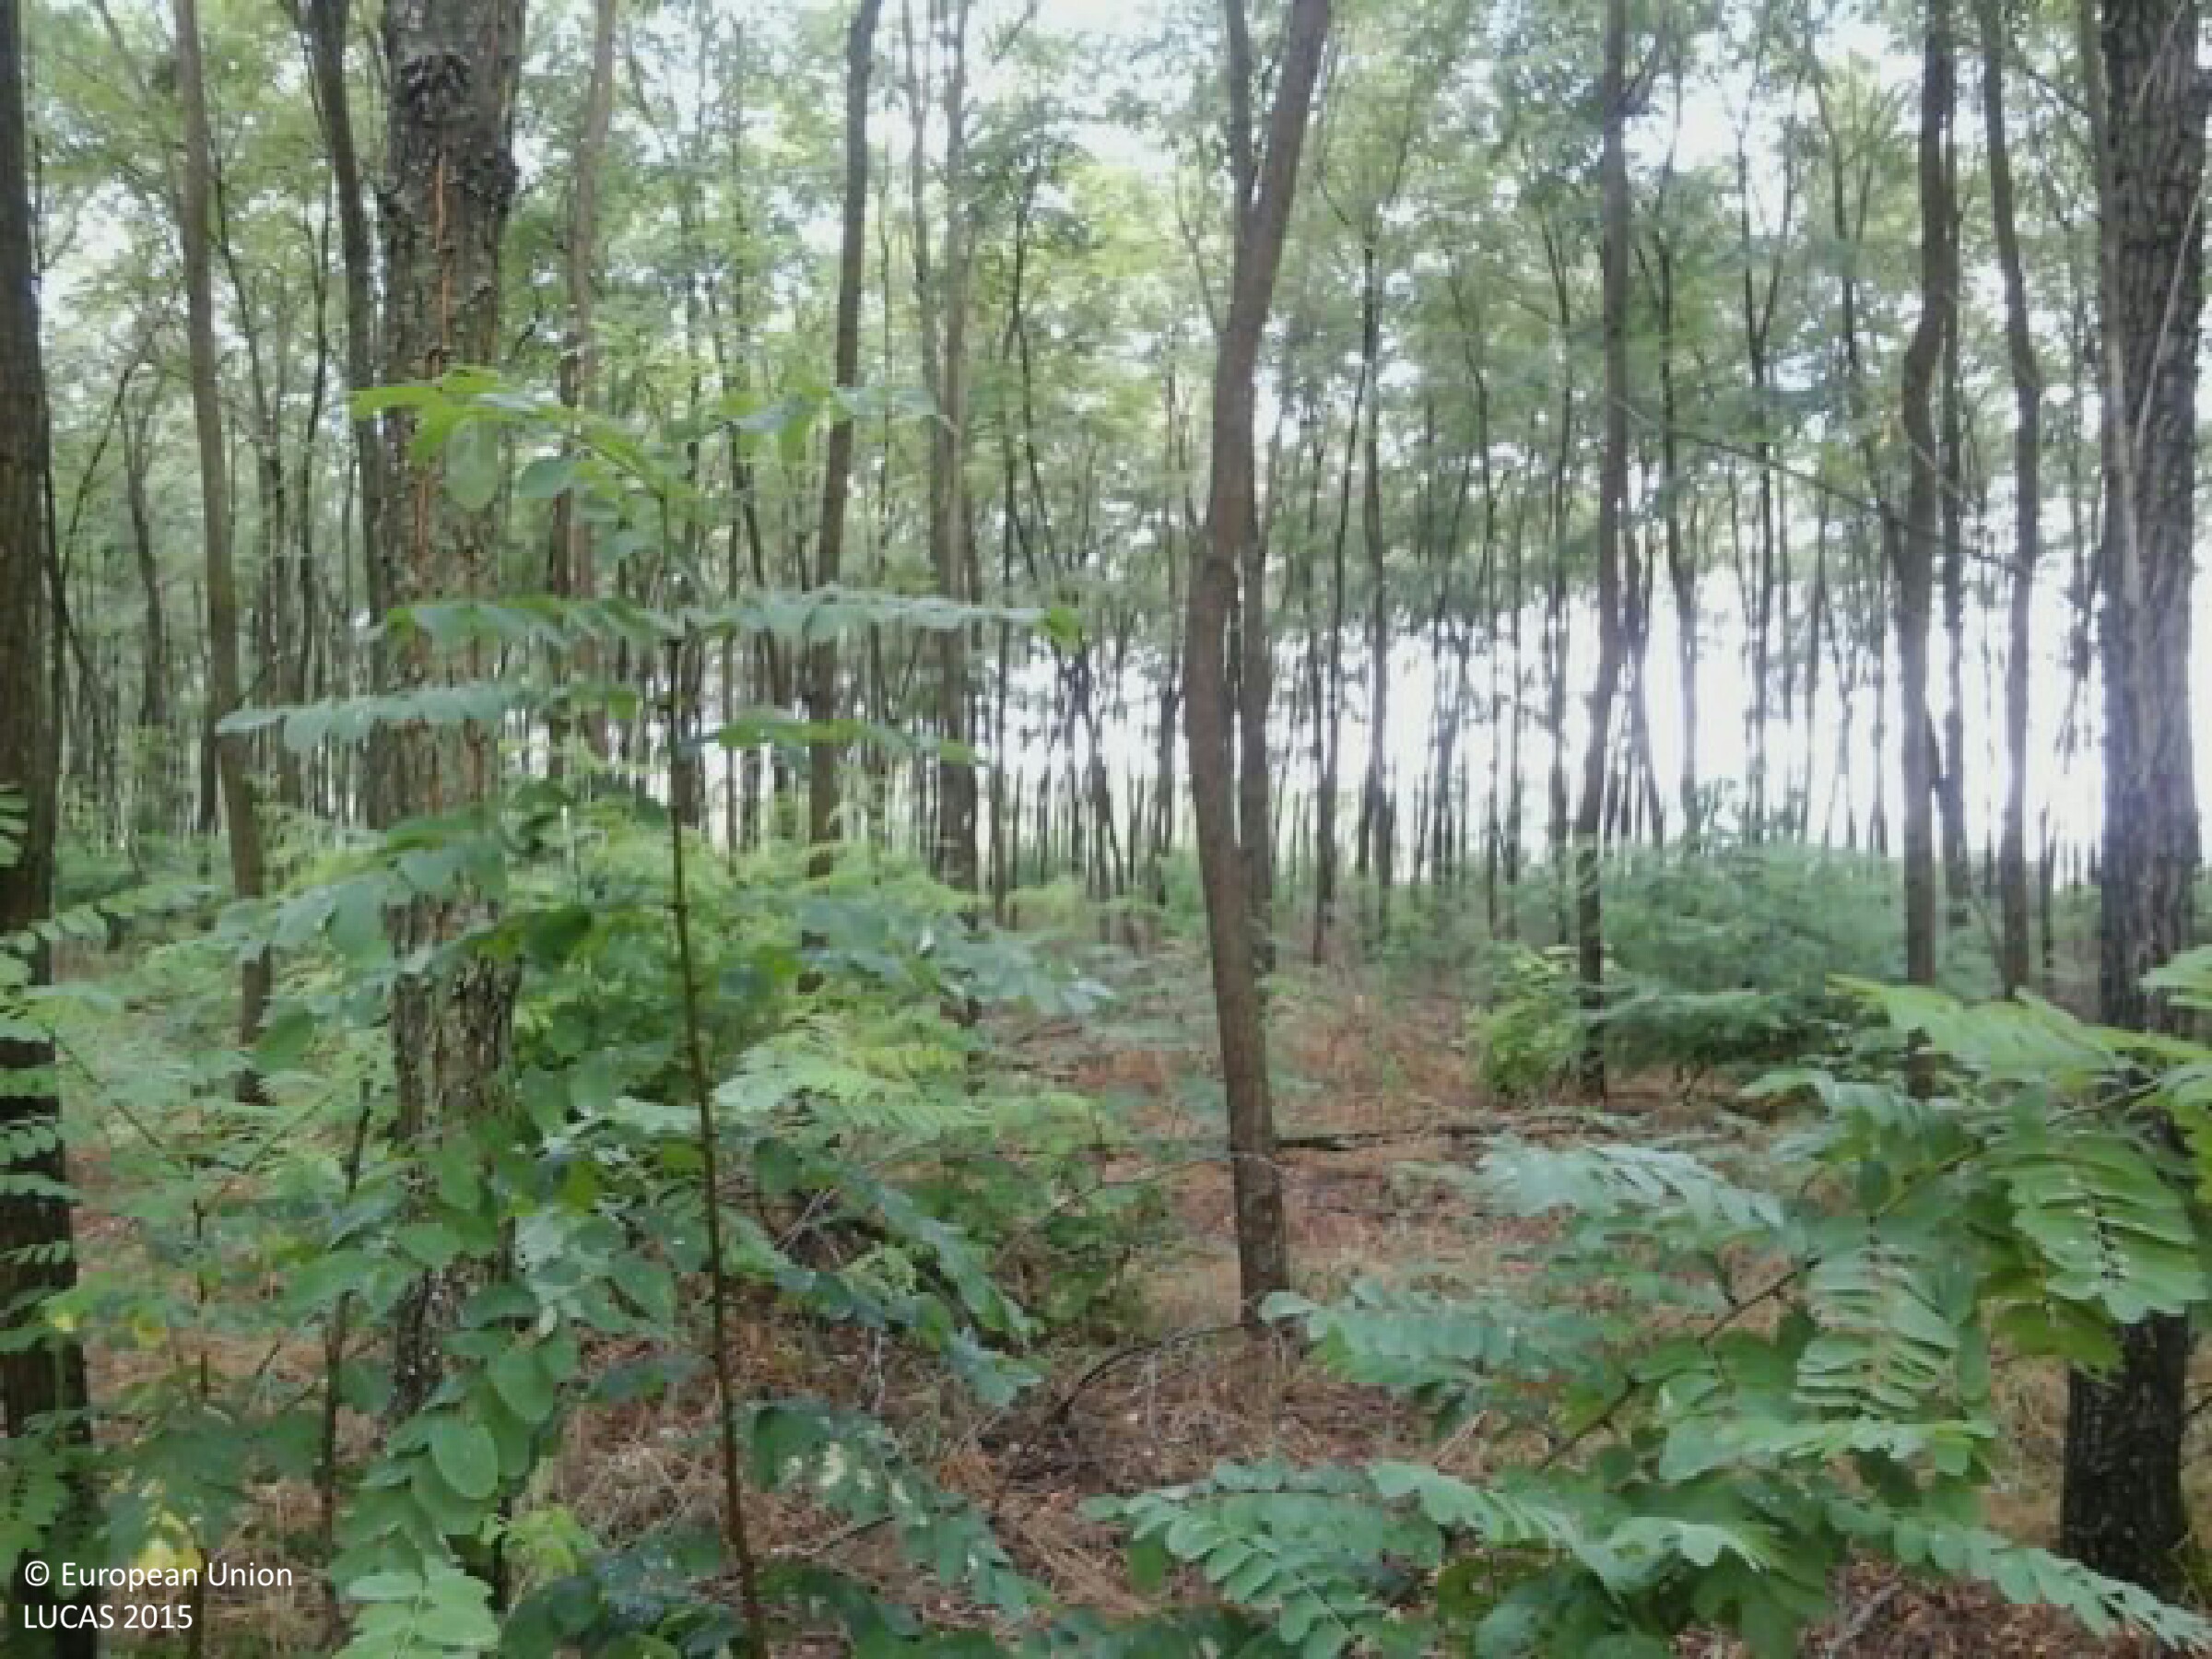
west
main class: Woodland
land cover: Broadleaved woodland
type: exotic forest
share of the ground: > 75 %
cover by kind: broadleaved forest trees 85 %, shrubs 10 %, herbaceous plants 5 %
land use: Forestry
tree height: > 5 m
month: August
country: HU
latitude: 47.1364
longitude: 19.7658
